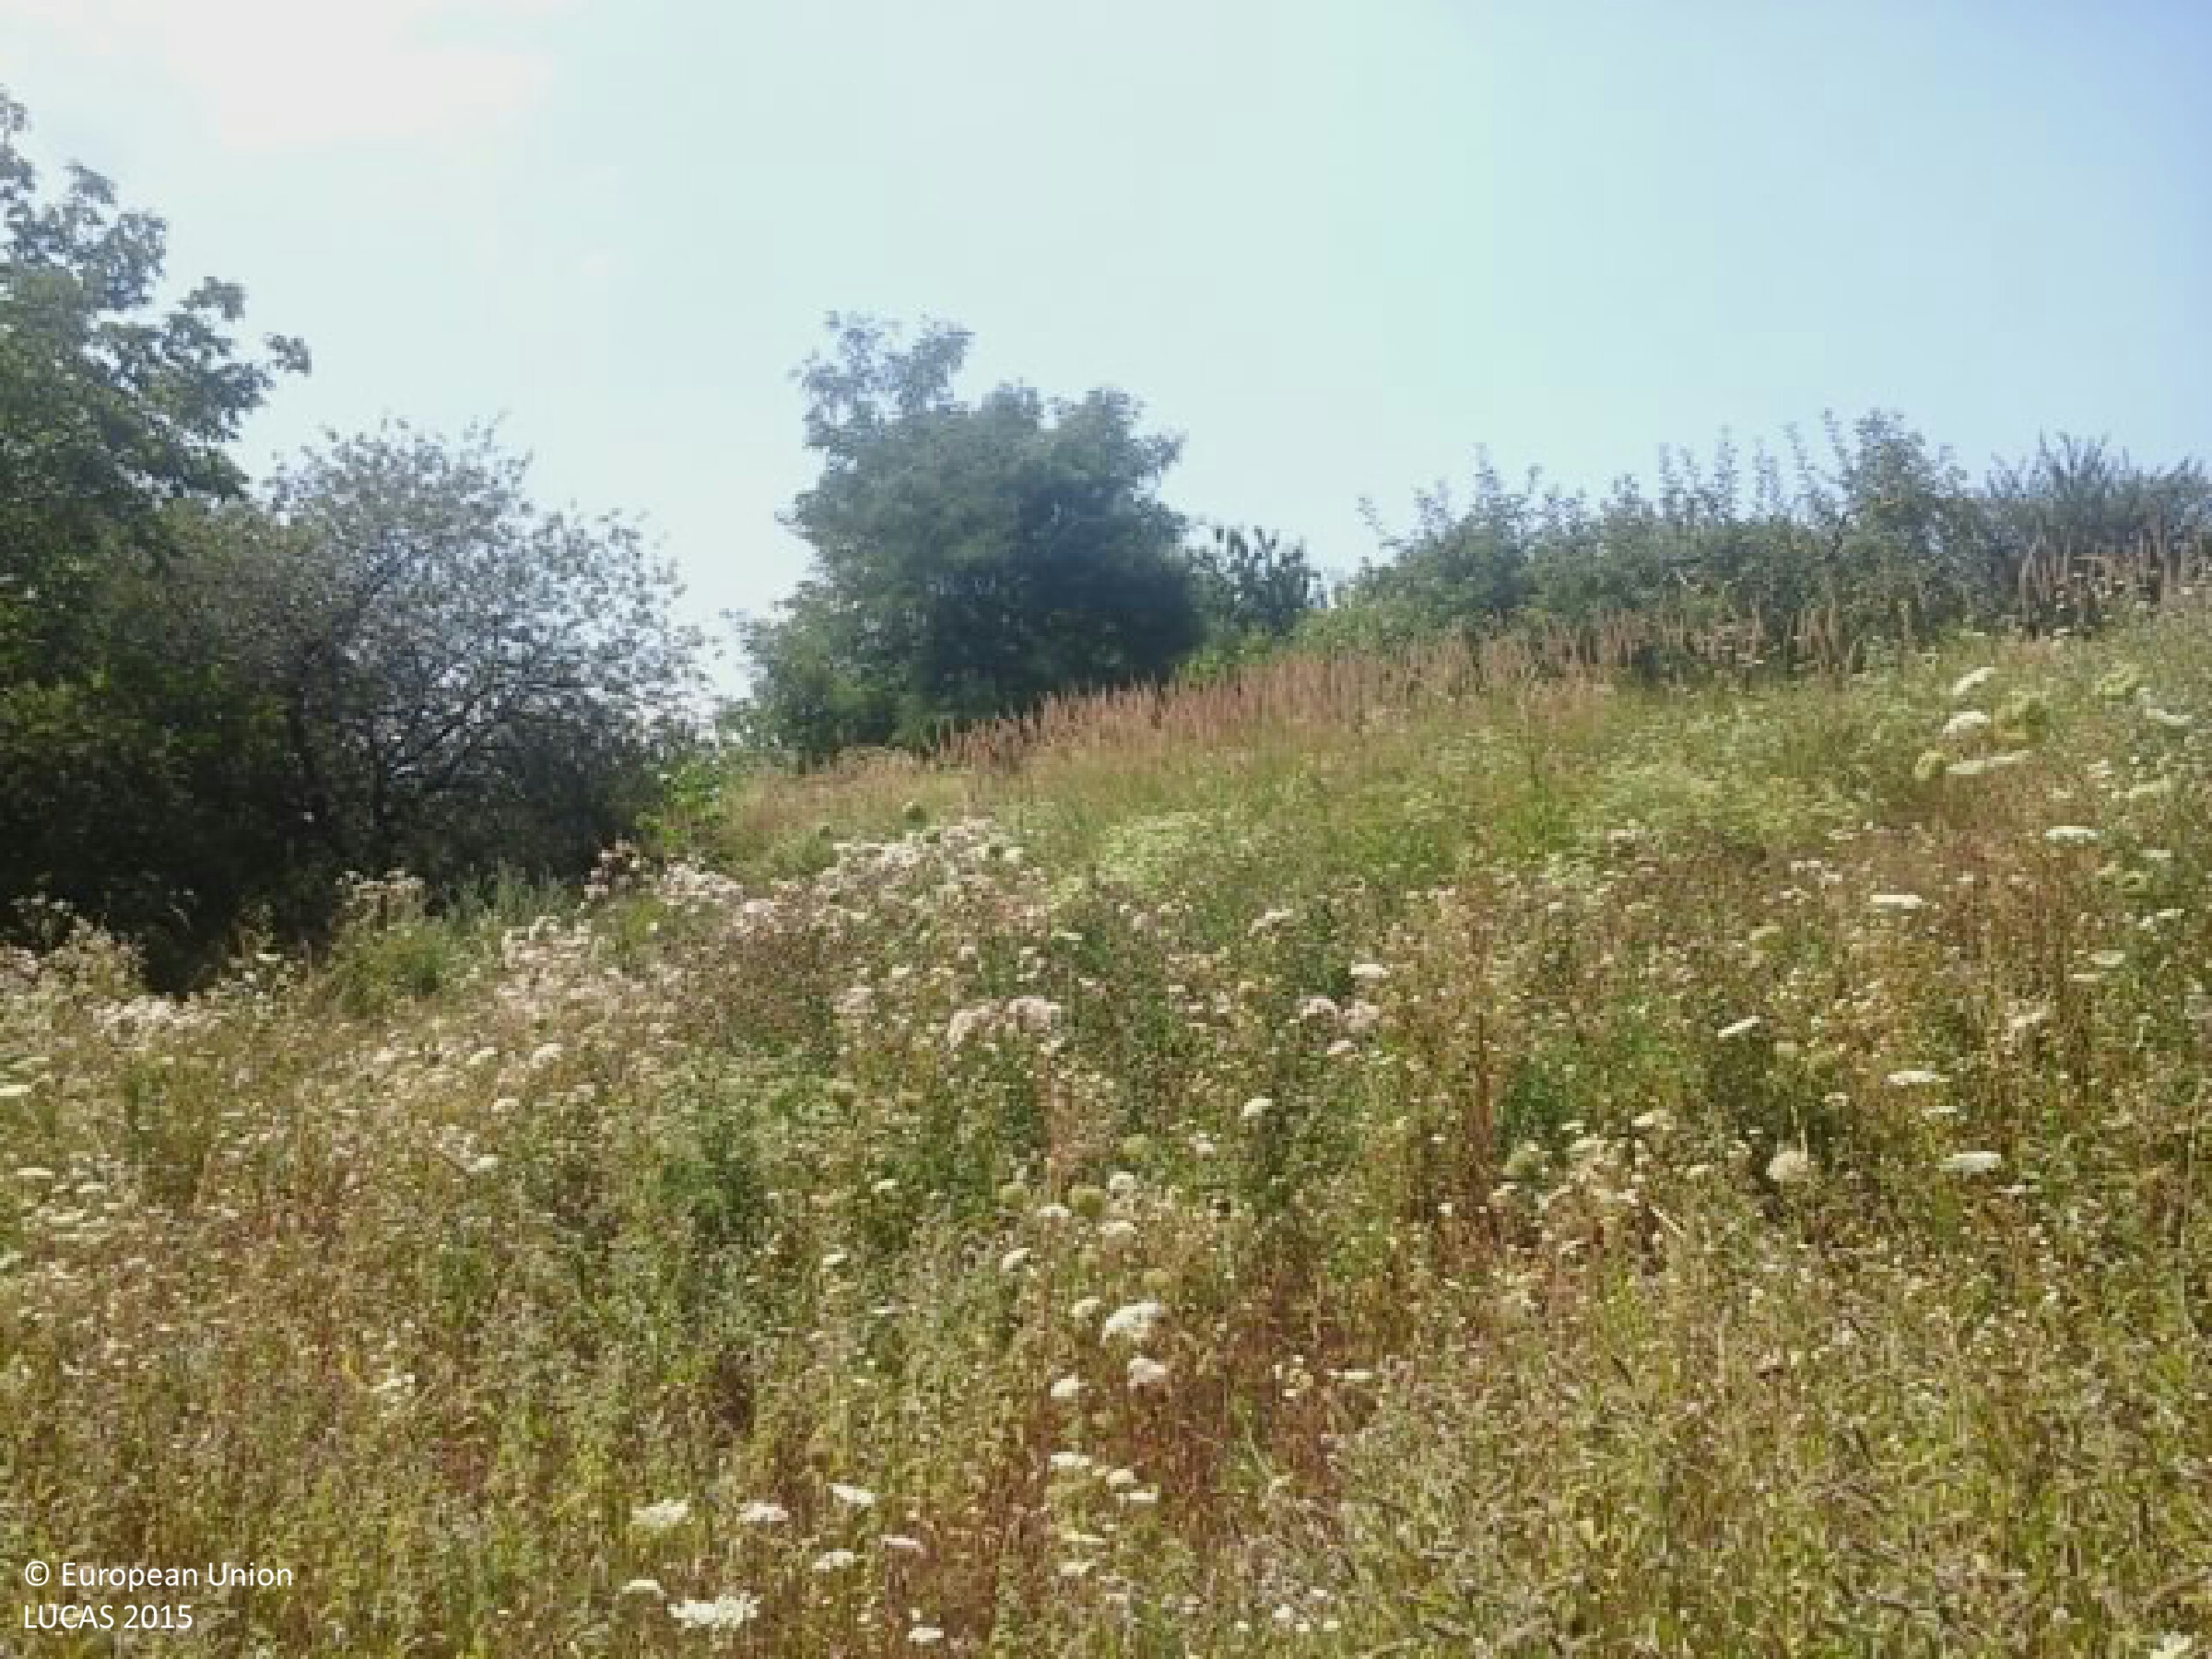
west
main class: Grassland
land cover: Grassland with sparse tree/shrub cover
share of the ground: > 75 %
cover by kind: herbaceous plants 85 %, shrubs 10 %, broadleaved forest trees 5 %
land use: Agriculture (excluding fallow land and kitchen gardens)
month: August
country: HU
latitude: 46.1961
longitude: 18.2361
